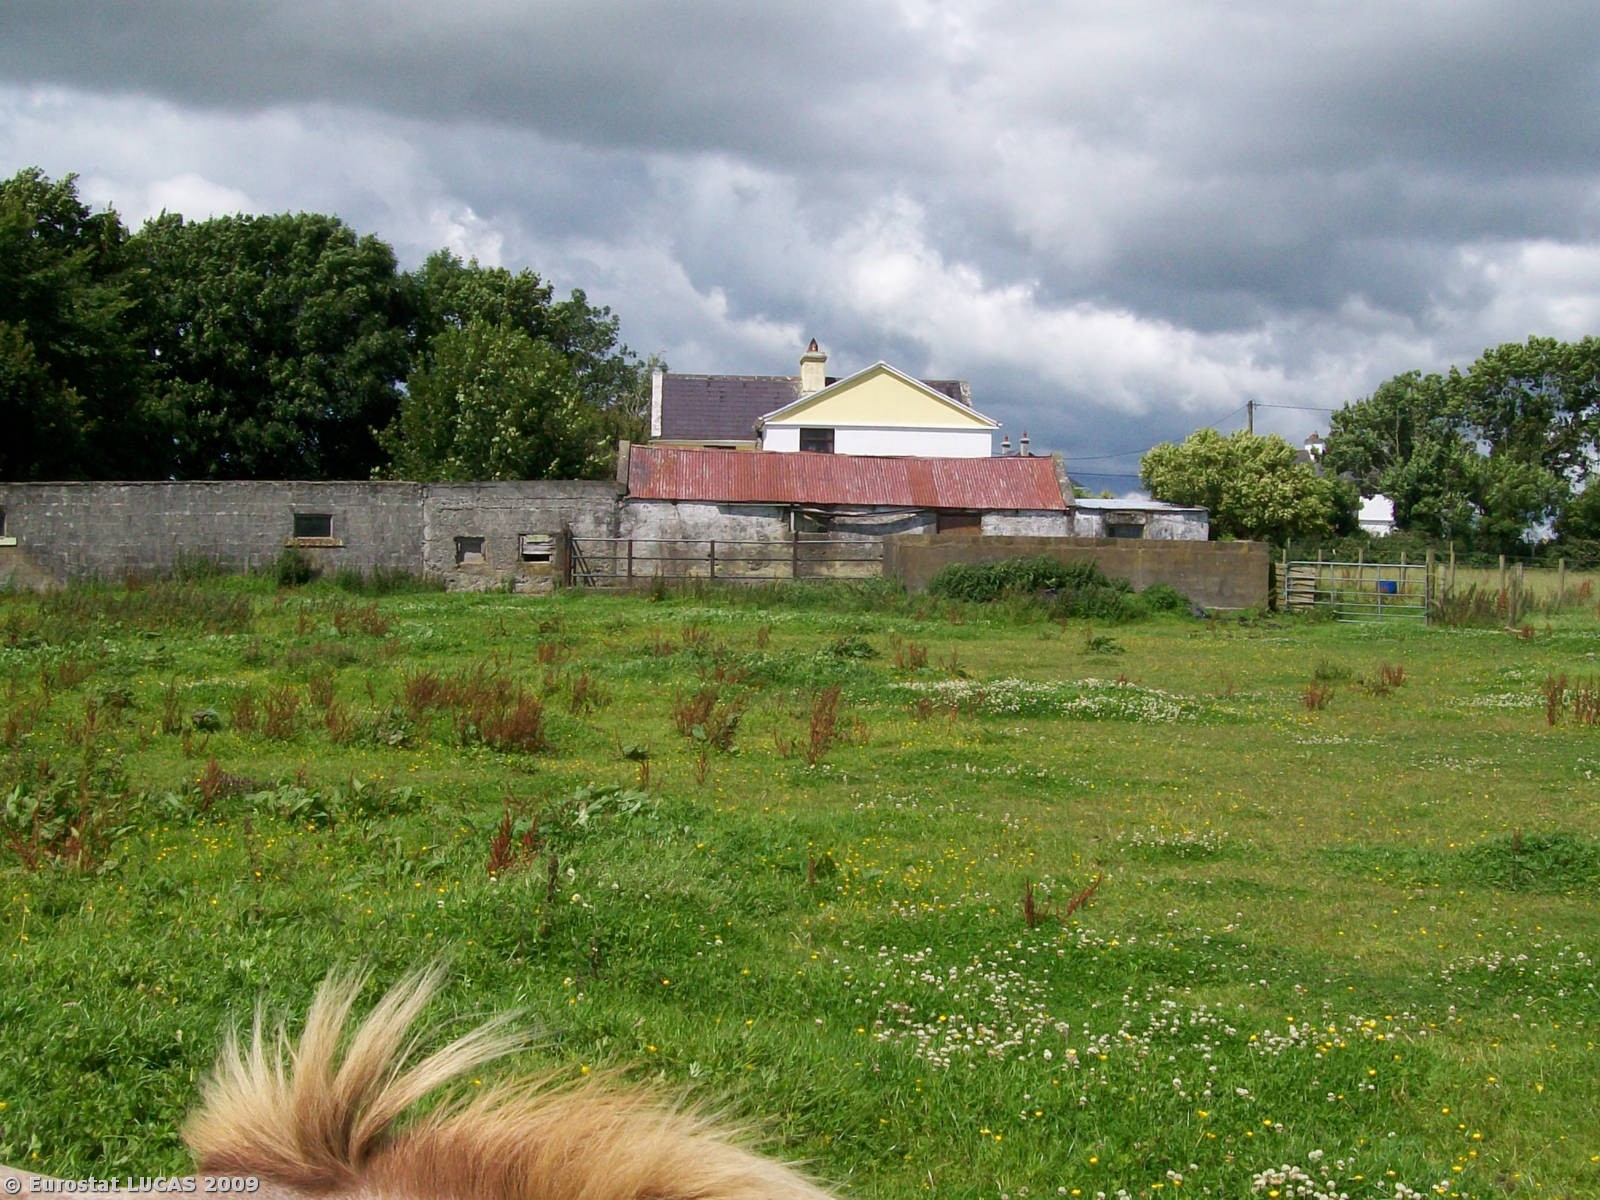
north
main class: Grassland
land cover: Grassland without tree/shrub cover
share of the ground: > 75 %
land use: Agriculture (excluding fallow land and kitchen gardens)
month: July
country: IE
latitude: 53.1592
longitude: -8.7325
